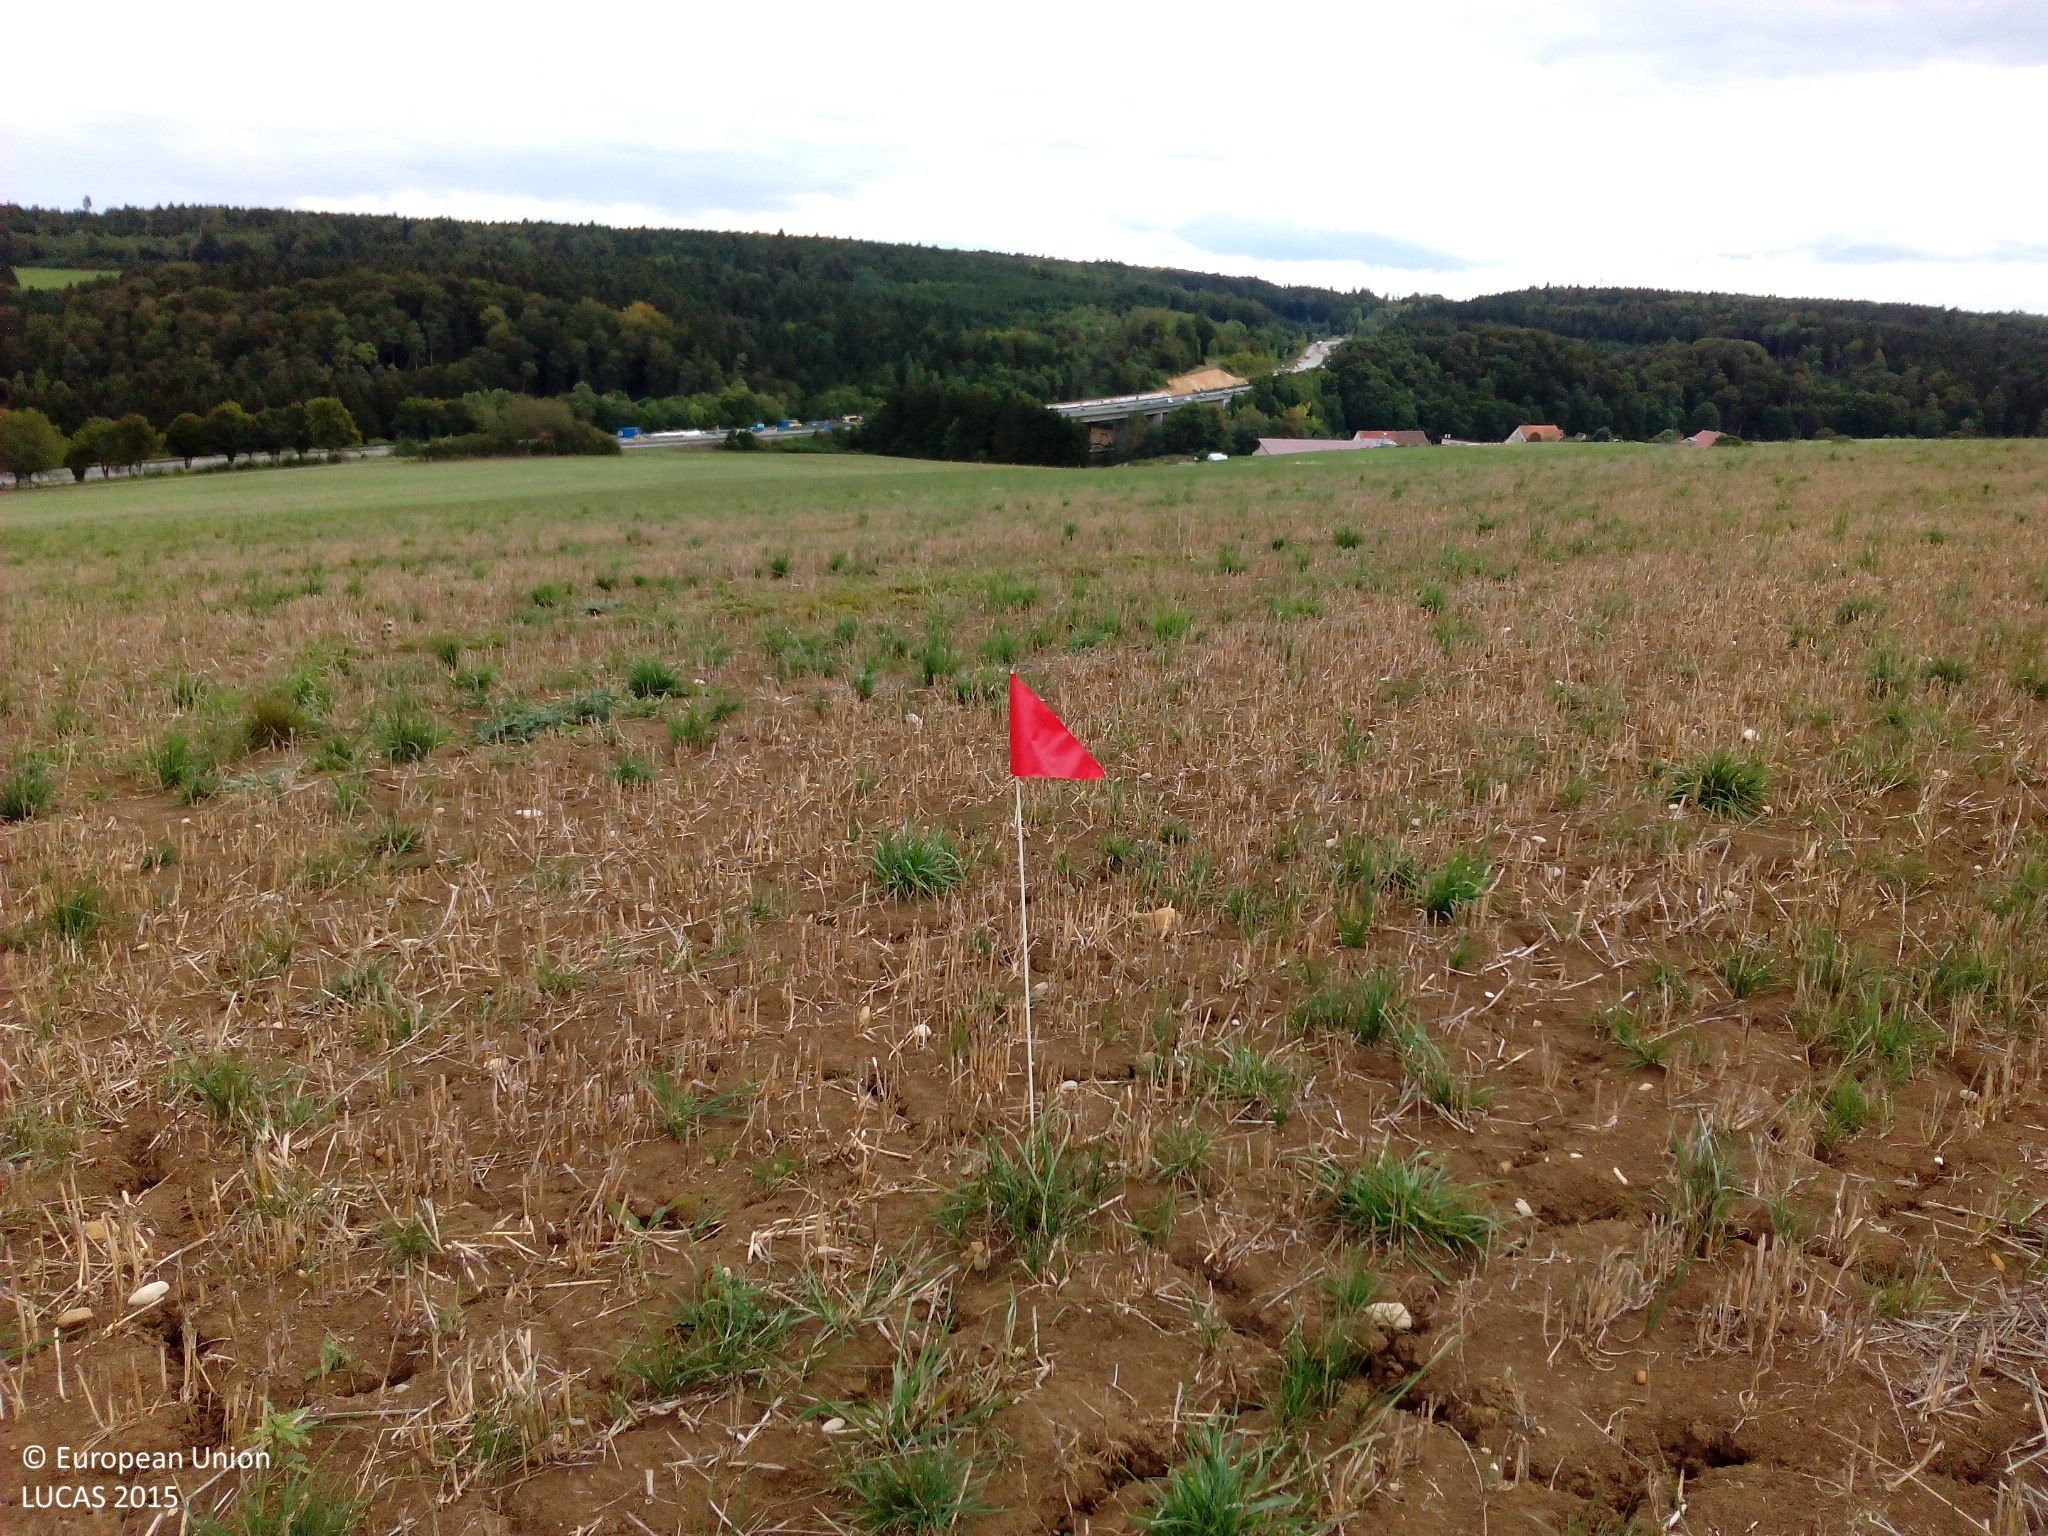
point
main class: Grassland
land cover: Spontaneously vegetated surfaces
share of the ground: 10 - 25 %
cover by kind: unconsolidated bare surface 70 %, herbaceous plants 25 %
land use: Agriculture (excluding fallow land and kitchen gardens)
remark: Harvested field
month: September
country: DE
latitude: 47.8919
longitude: 8.7035
